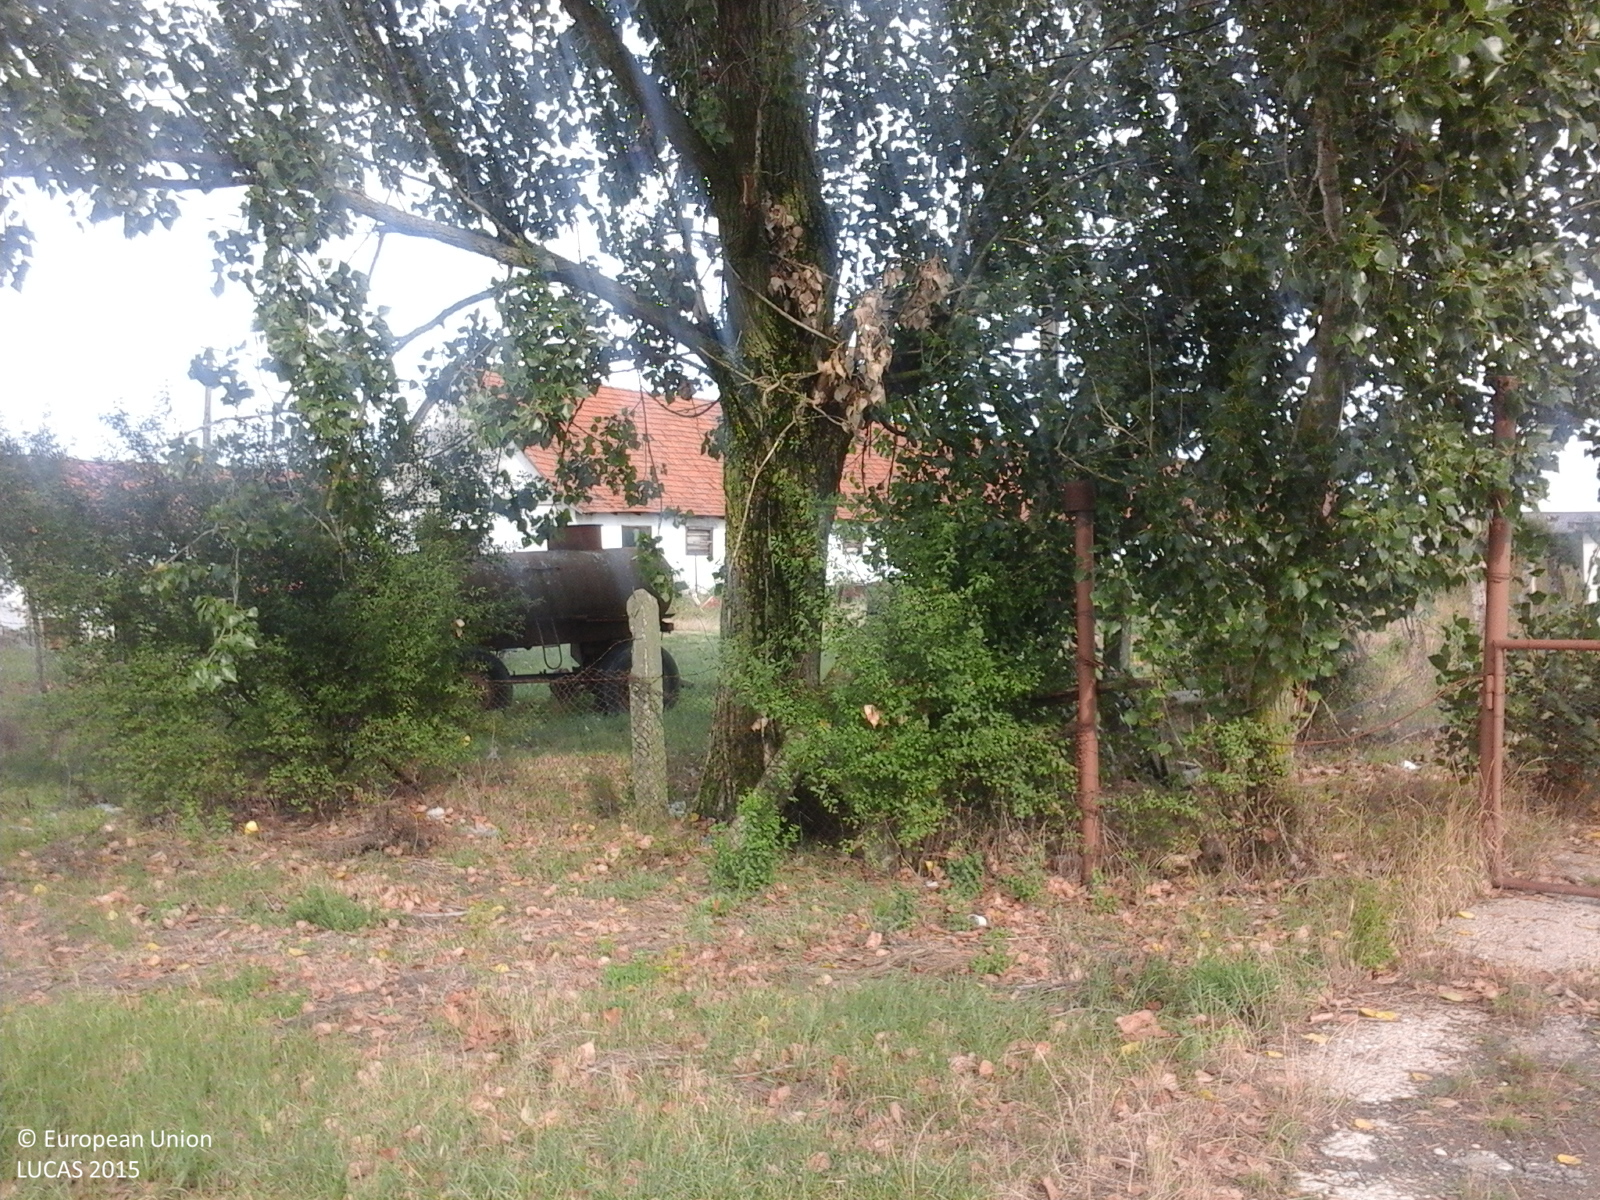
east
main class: Grassland
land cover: Grassland without tree/shrub cover
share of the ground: > 75 %
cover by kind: herbaceous plants 100 %
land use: Agriculture (excluding fallow land and kitchen gardens)
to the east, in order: Grassland without tree/shrub cover; Artificial constructions in urban areas; Abandoned hedges; Grassland without tree/shrub cover
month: August
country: RO
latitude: 45.6116
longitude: 21.4058
